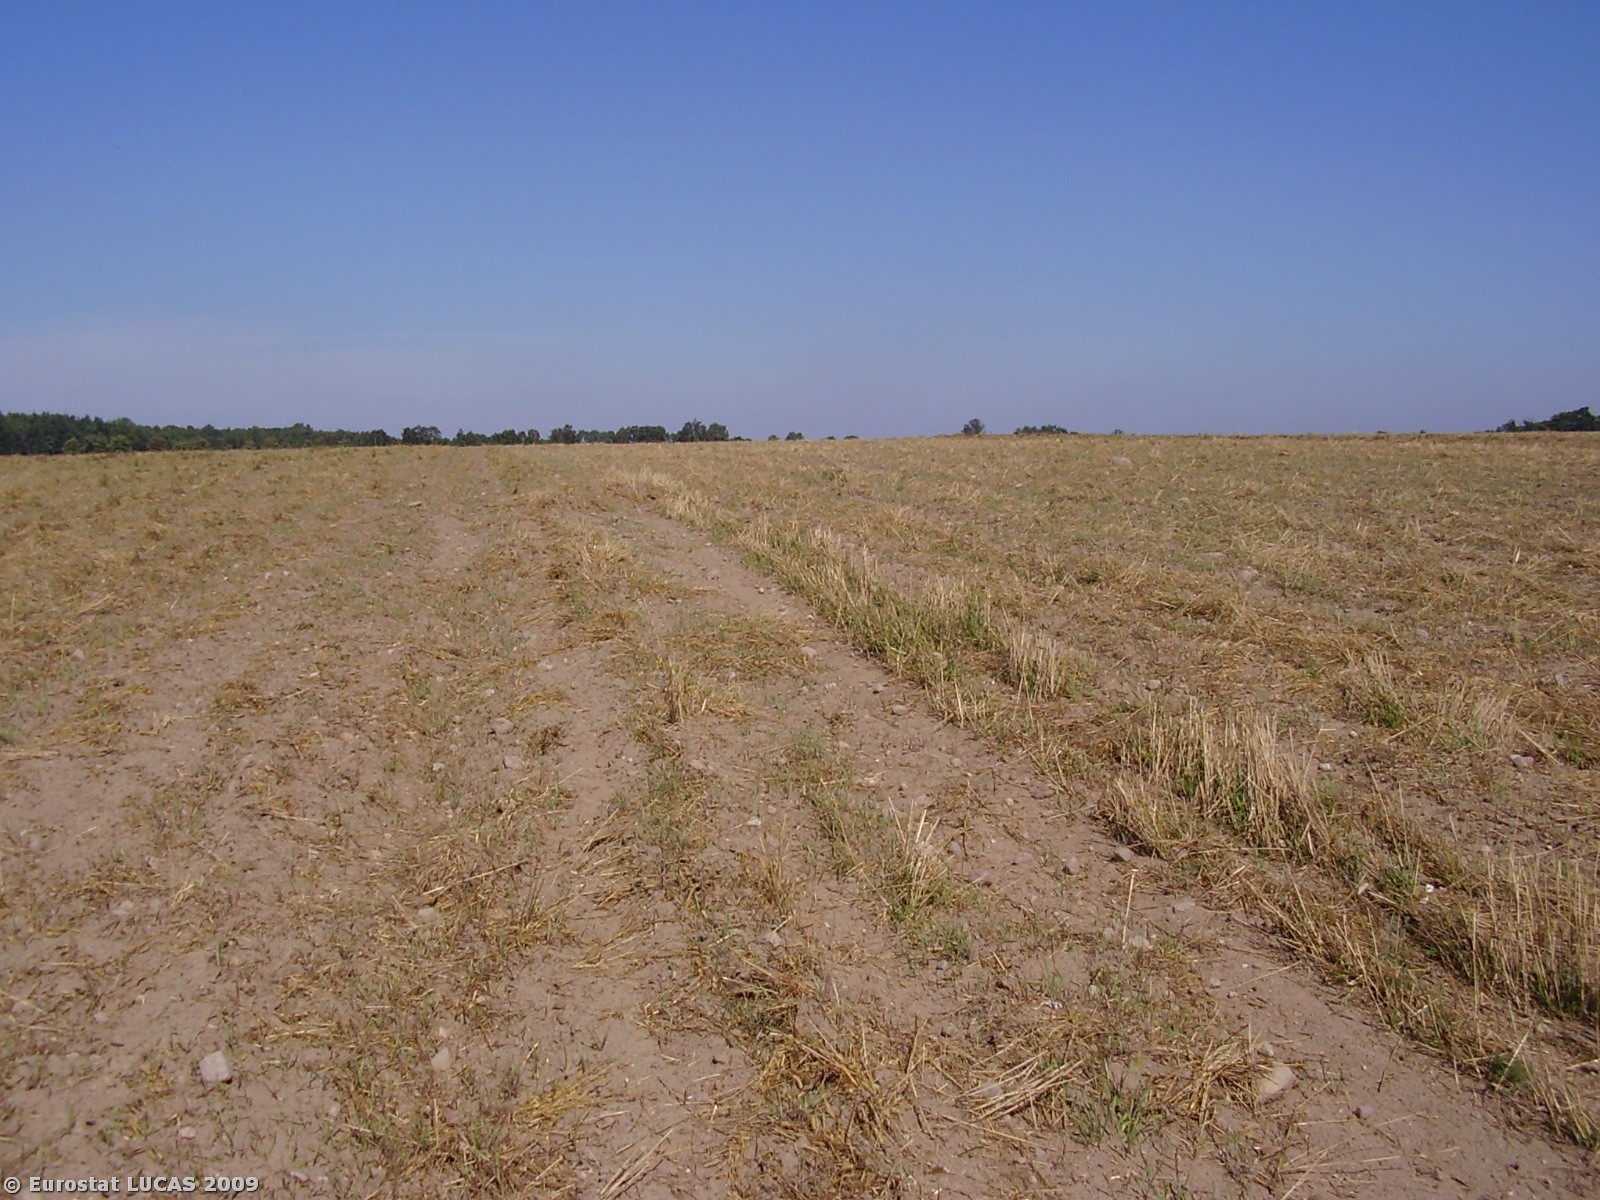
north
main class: Cropland
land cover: Rye
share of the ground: < 10 %
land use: Agriculture (excluding fallow land and kitchen gardens)
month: August
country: PL
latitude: 51.3906
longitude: 16.1140
